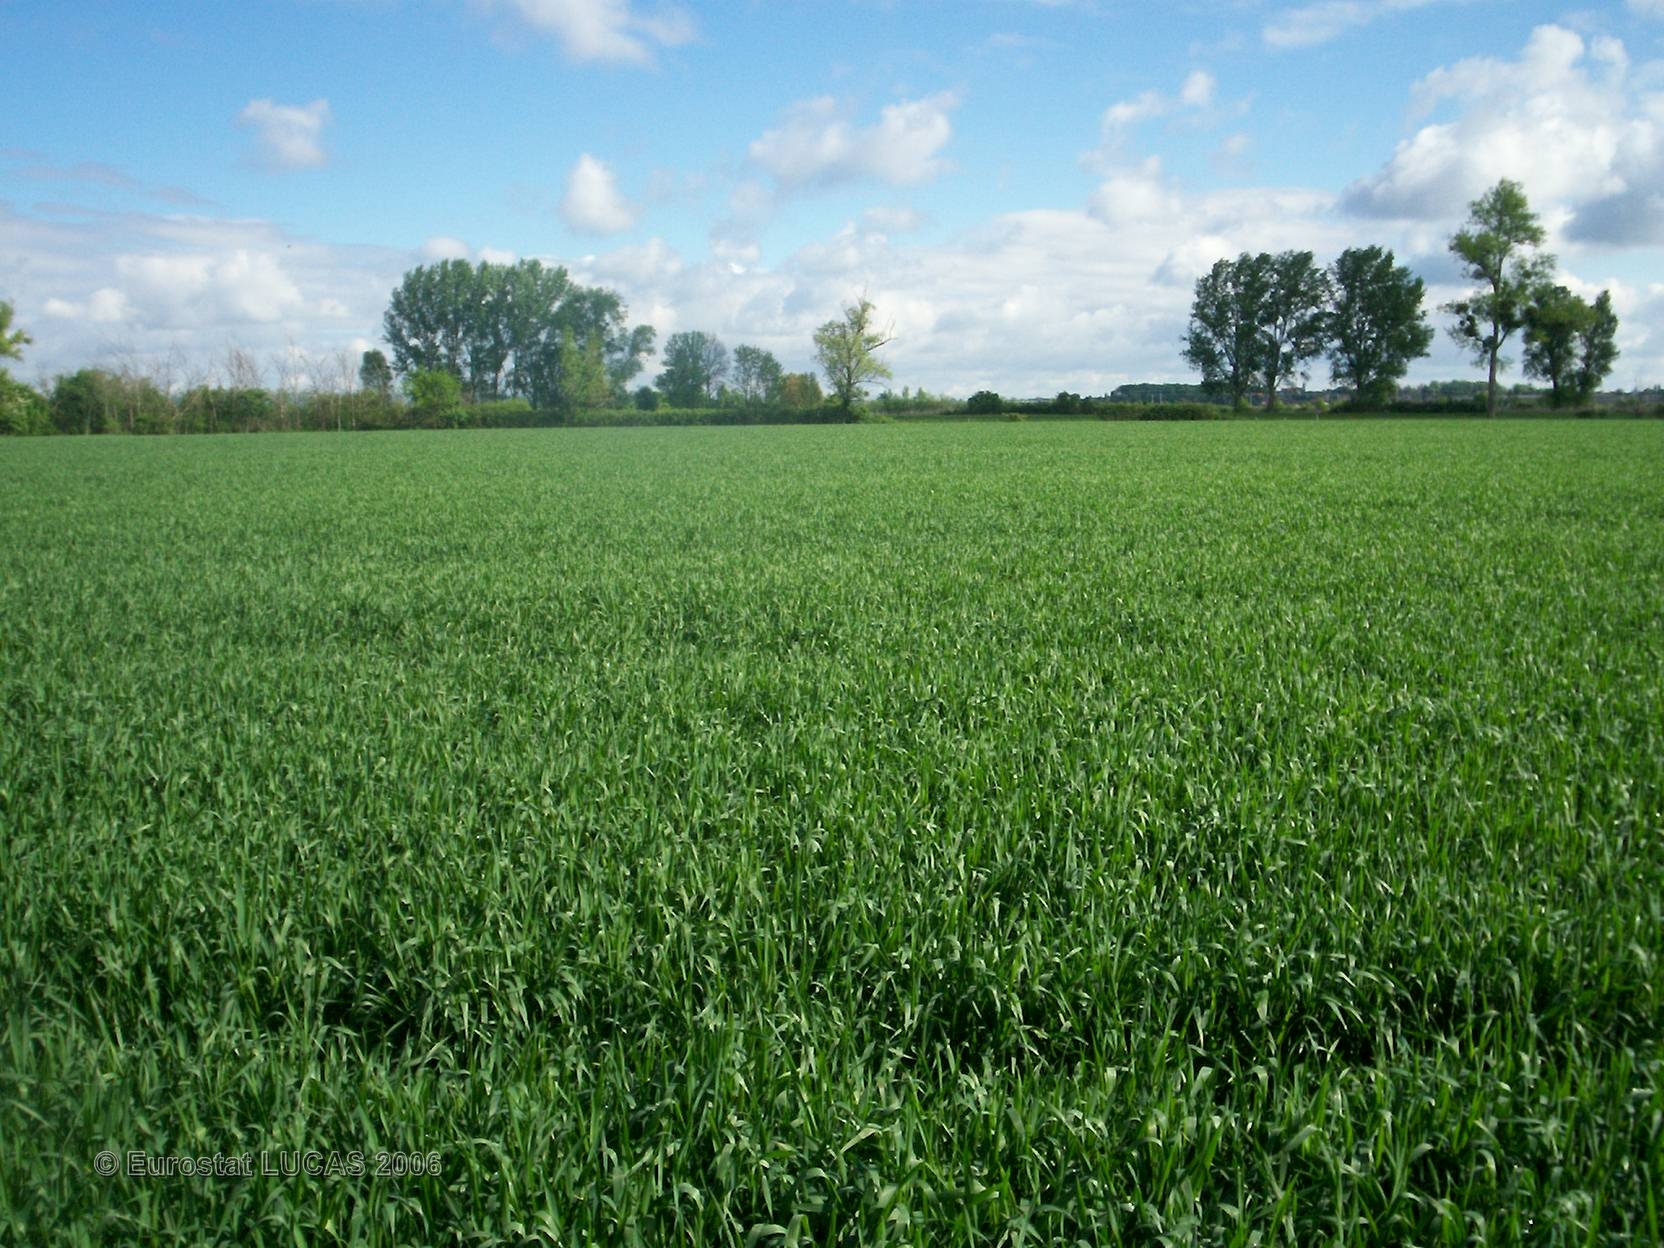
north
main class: Cropland
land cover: Common wheat
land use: Agriculture (excluding fallow land and kitchen gardens)
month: May
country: FR
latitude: 45.8986
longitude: 3.1814
